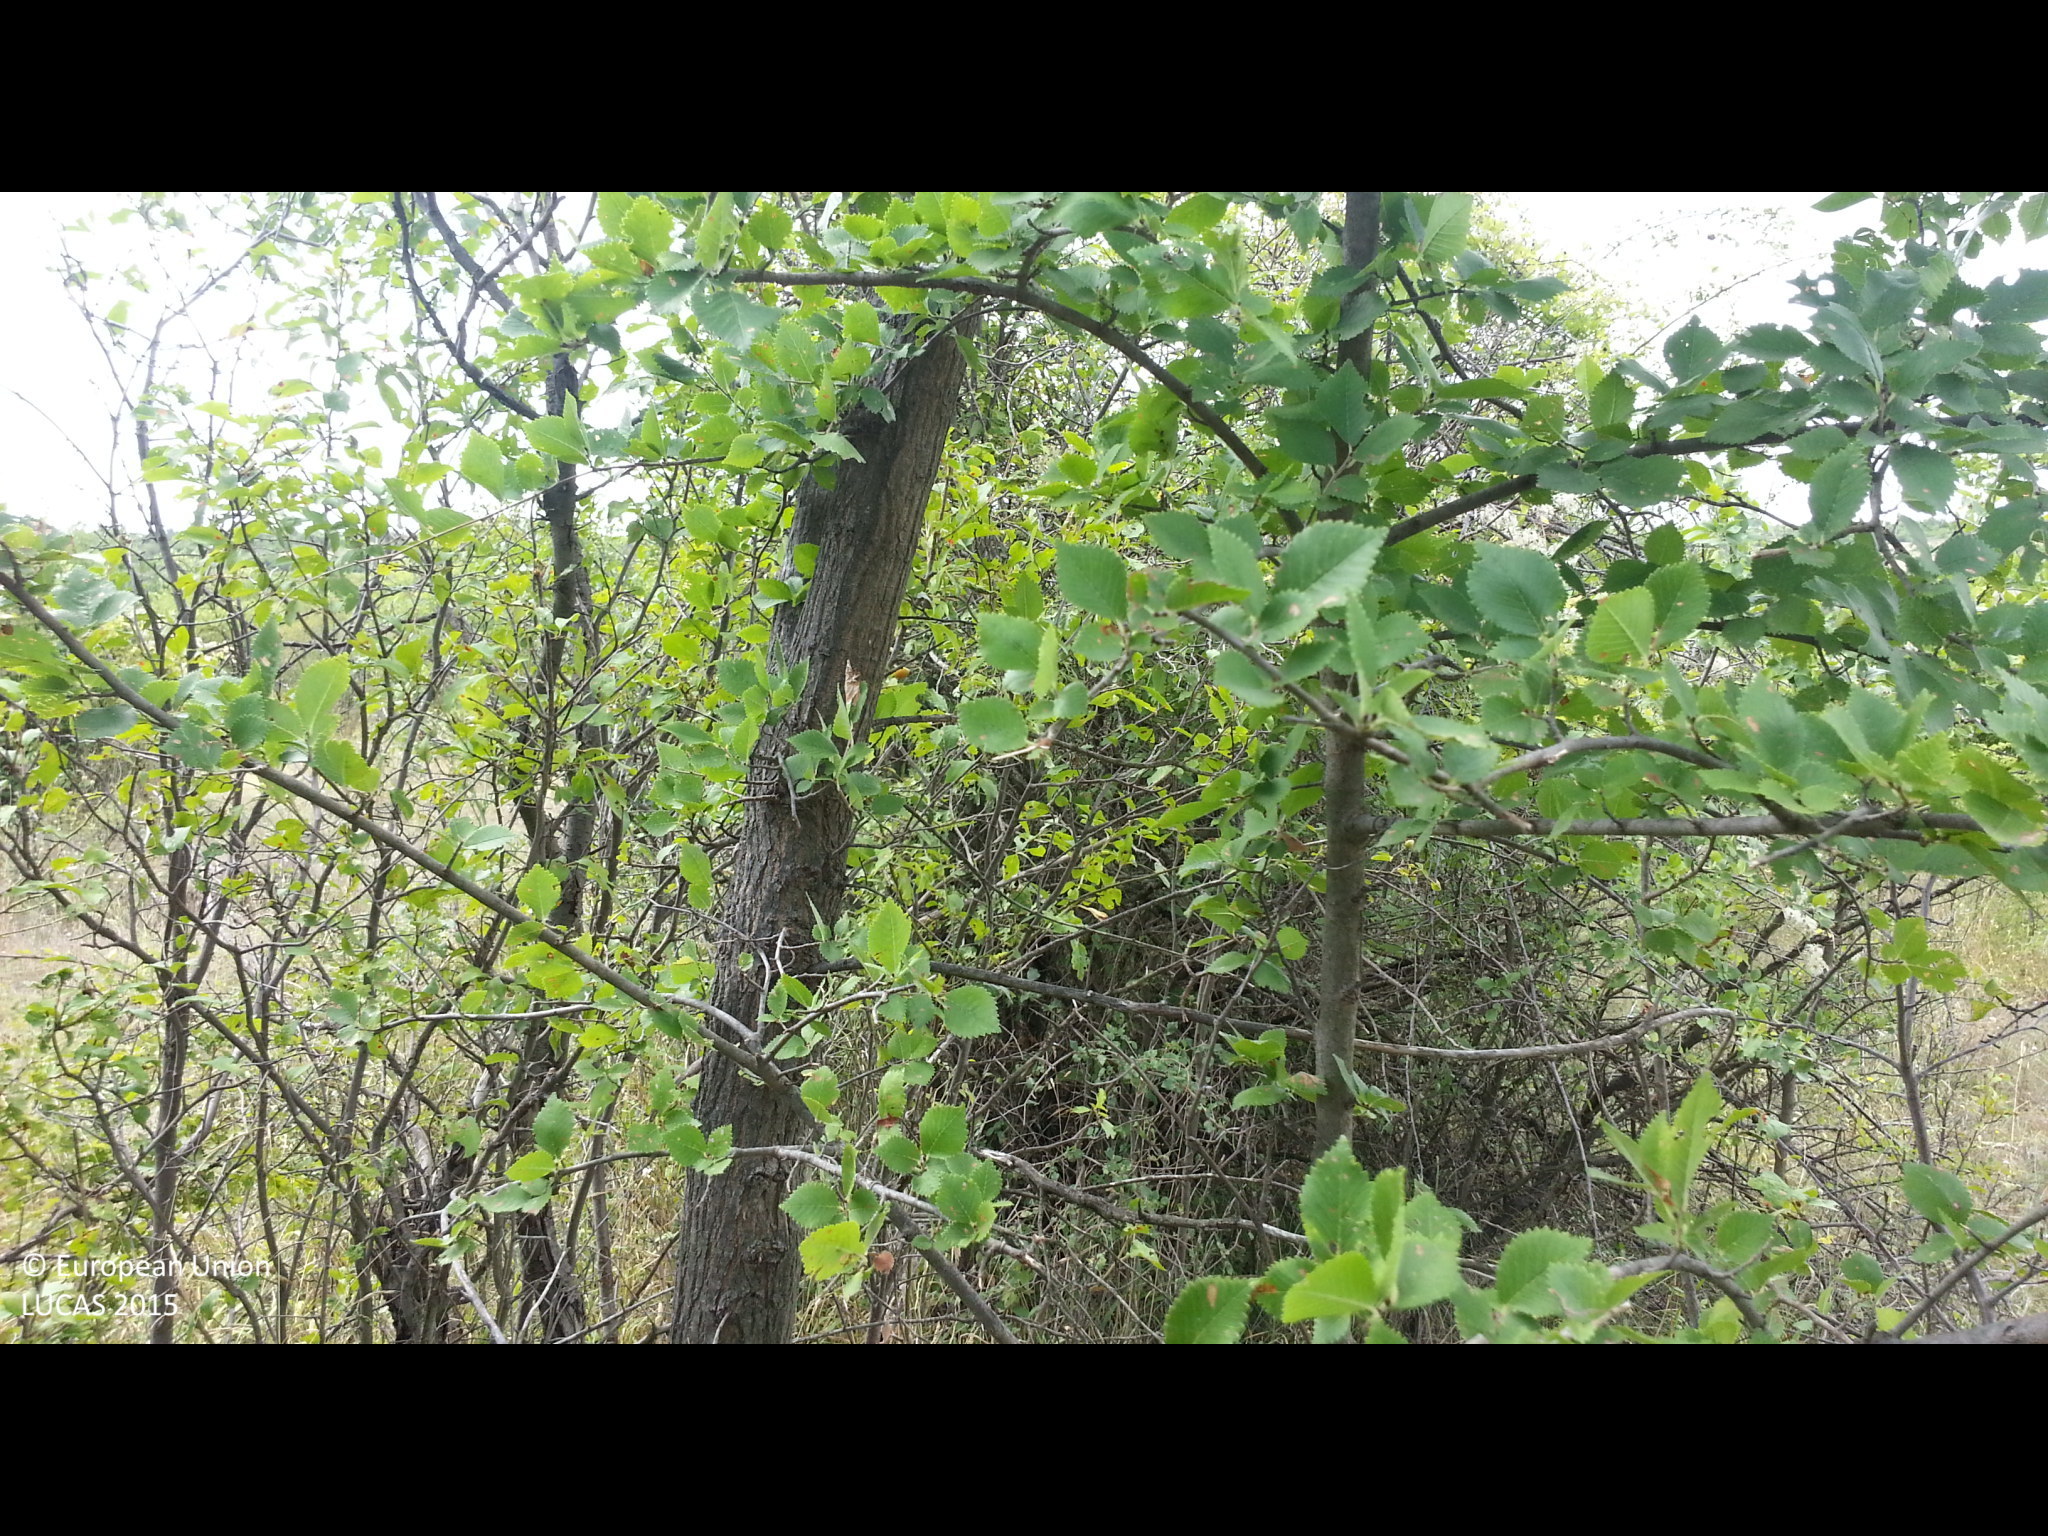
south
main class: Shrubland
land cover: Shrubland with sparse tree cover
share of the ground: > 75 %
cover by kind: herbaceous plants 60 %, shrubs 35 %, broadleaved forest trees 5 %
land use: Abandoned areas
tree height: < 5 m
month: August
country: BG
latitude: 42.2583
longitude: 23.0819
